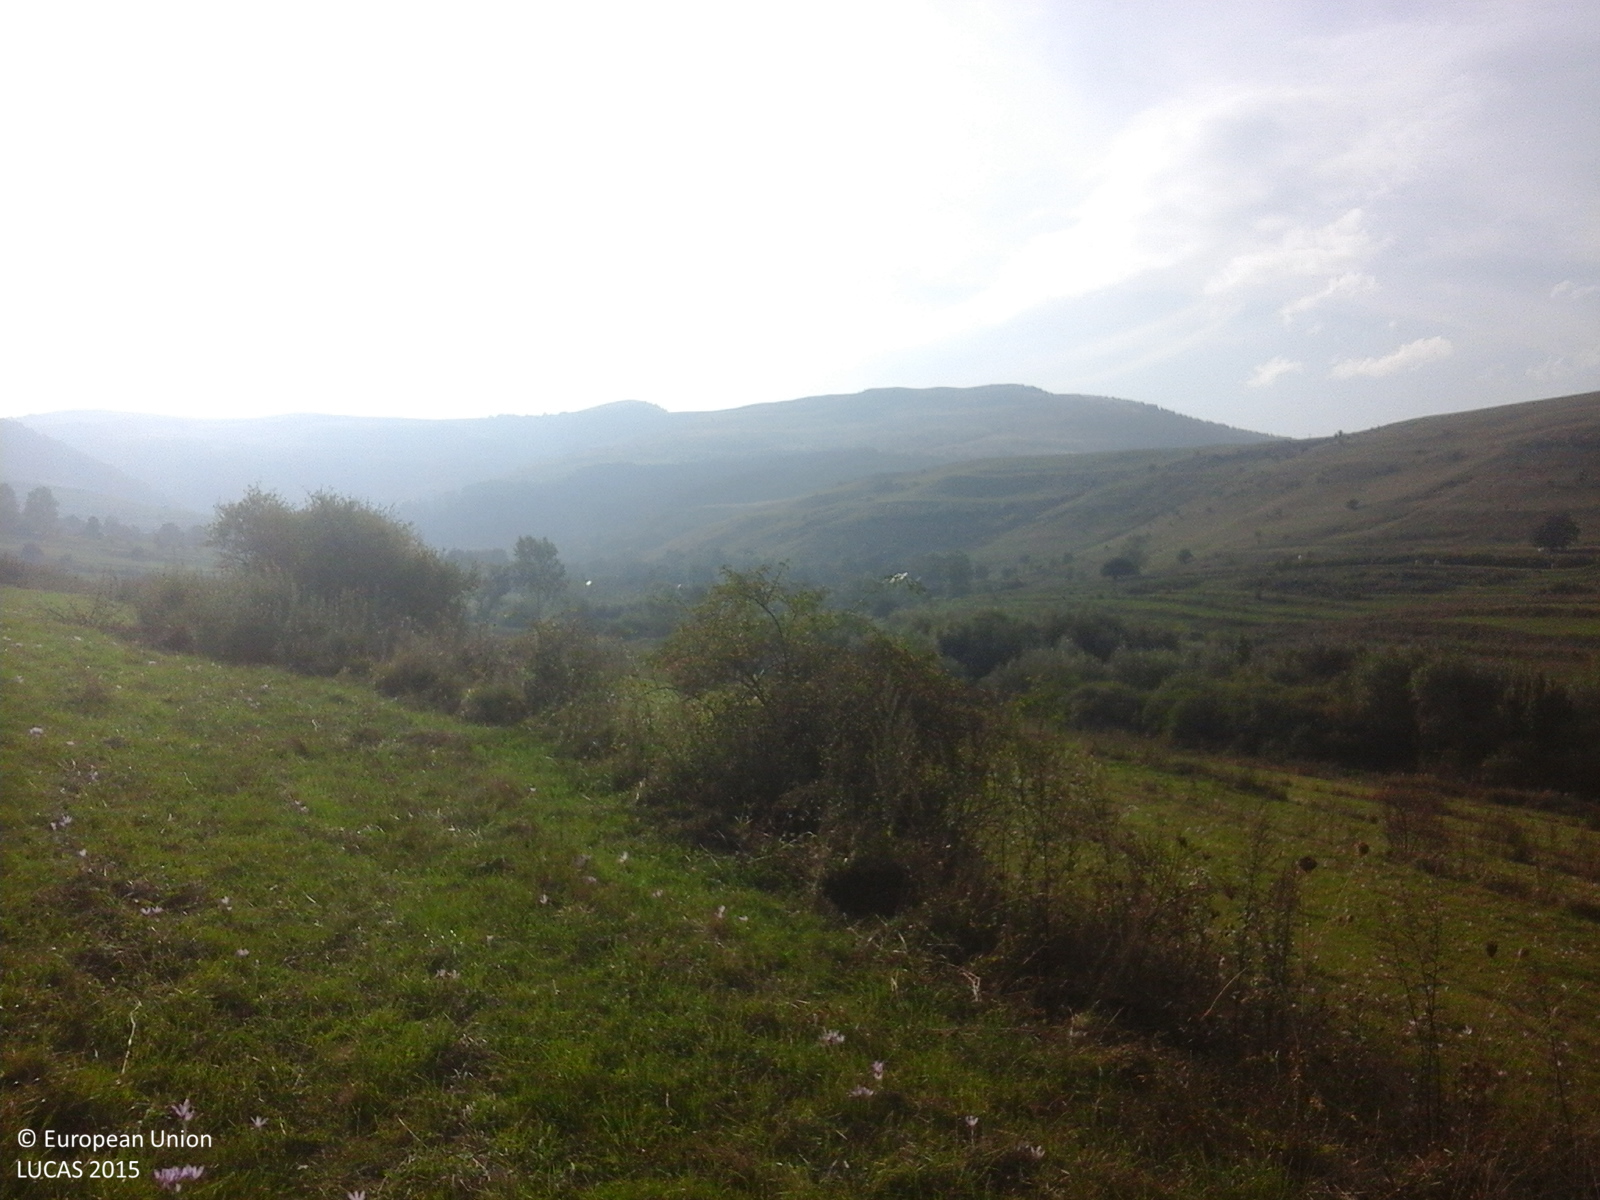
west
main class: Grassland
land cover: Grassland without tree/shrub cover
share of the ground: > 75 %
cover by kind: herbaceous plants 100 %
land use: Agriculture (excluding fallow land and kitchen gardens)
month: September
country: RO
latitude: 46.7801
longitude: 22.9614
